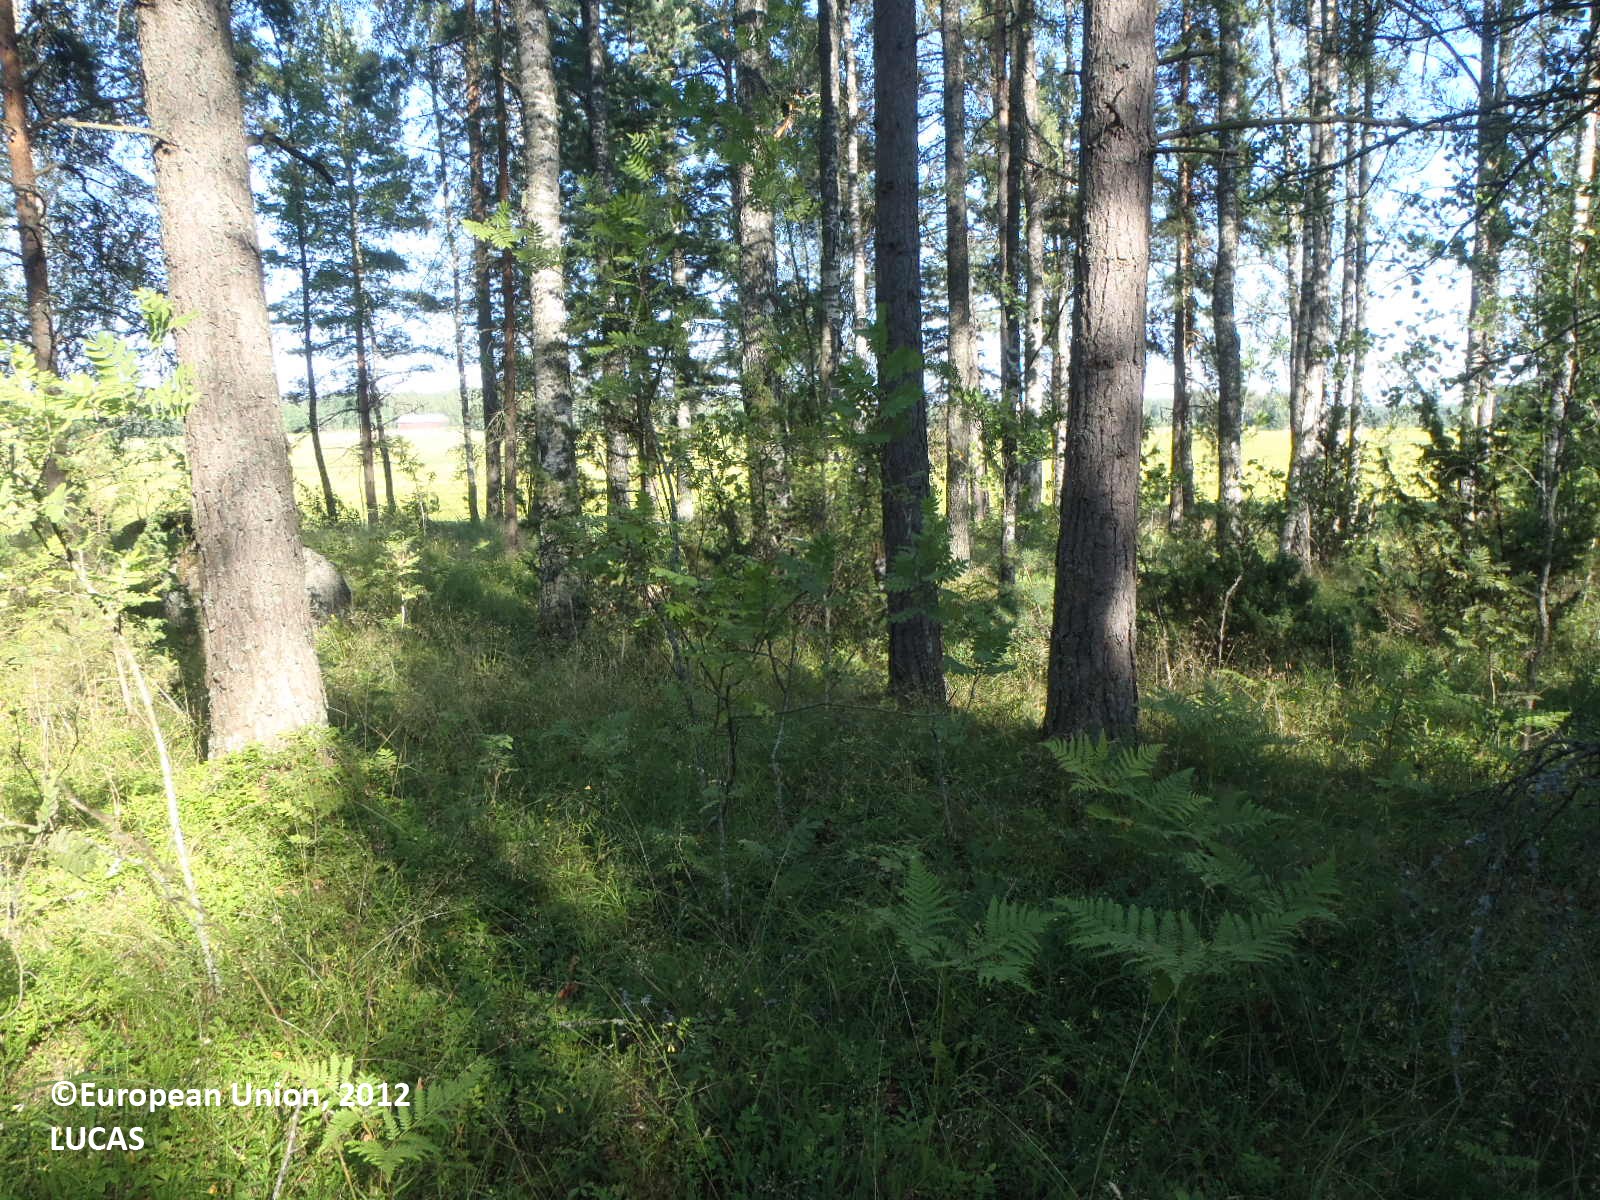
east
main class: Woodland
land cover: Pine dominated mixed woodland
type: boreal forest
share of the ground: 50 - 75 %
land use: Forestry
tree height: > 5 m
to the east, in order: Pine dominated mixed woodland; Grassland without tree/shrub cover; Barley; Grass margins; Ditches and canals; Grass margins; Arable land (only in case pi)
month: July
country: FI
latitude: 60.6188
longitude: 21.7350
